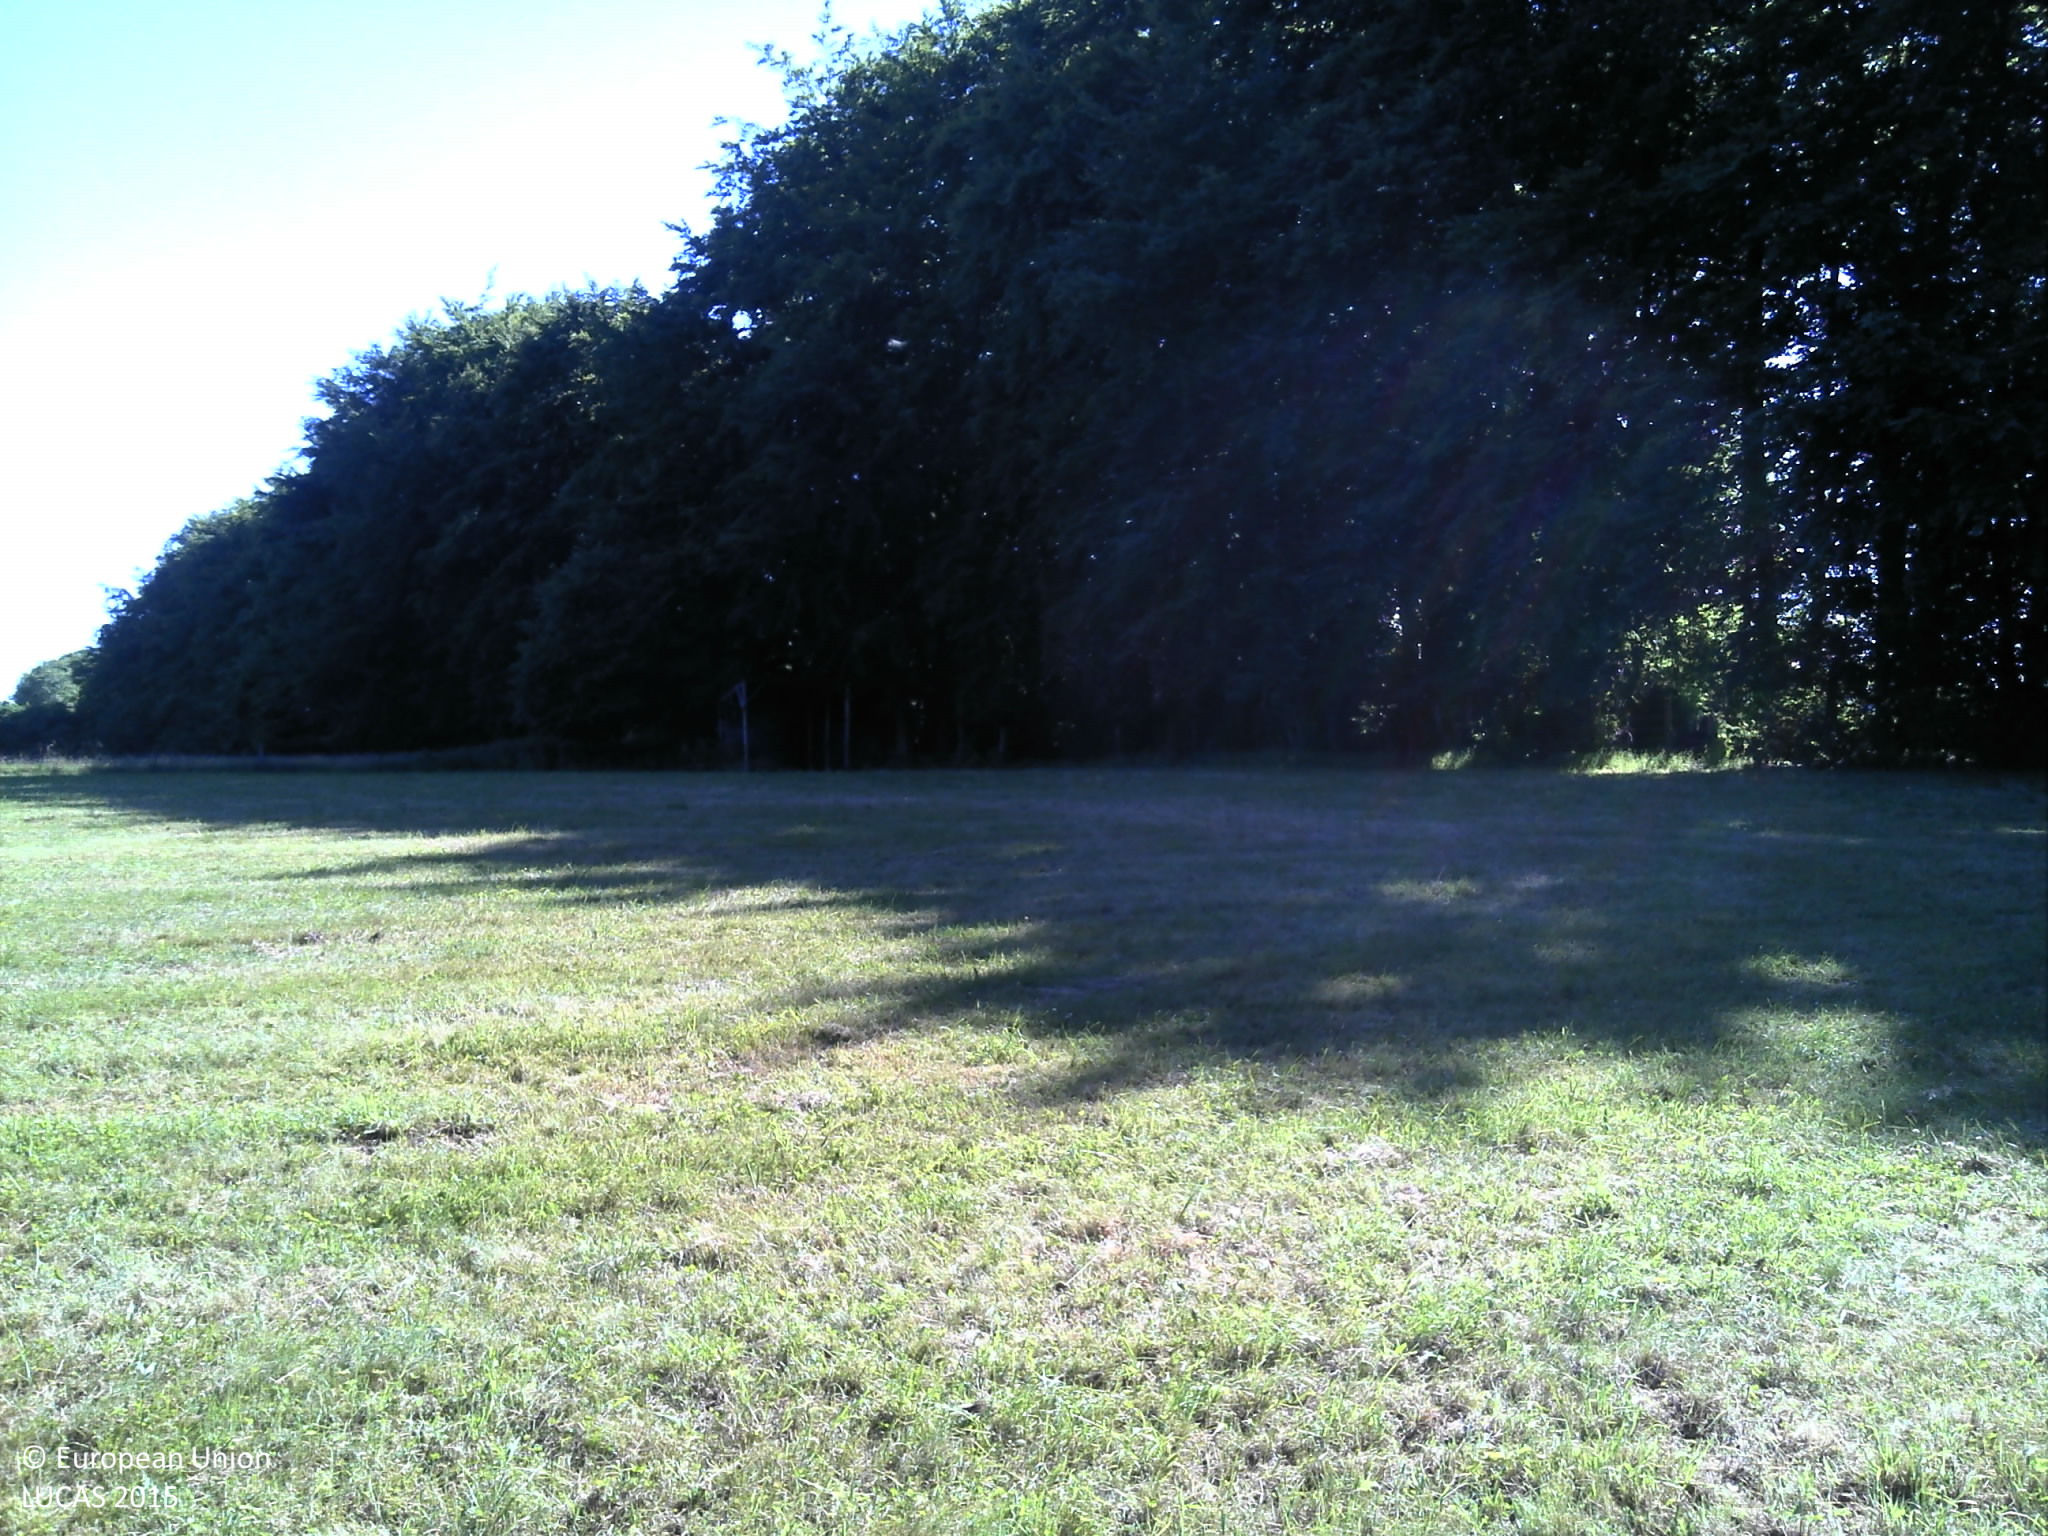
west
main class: Grassland
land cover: Grassland without tree/shrub cover
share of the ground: > 75 %
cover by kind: herbaceous plants 100 %
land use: Agriculture (excluding fallow land and kitchen gardens)
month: June
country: FR
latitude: 49.9574
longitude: 4.7977
